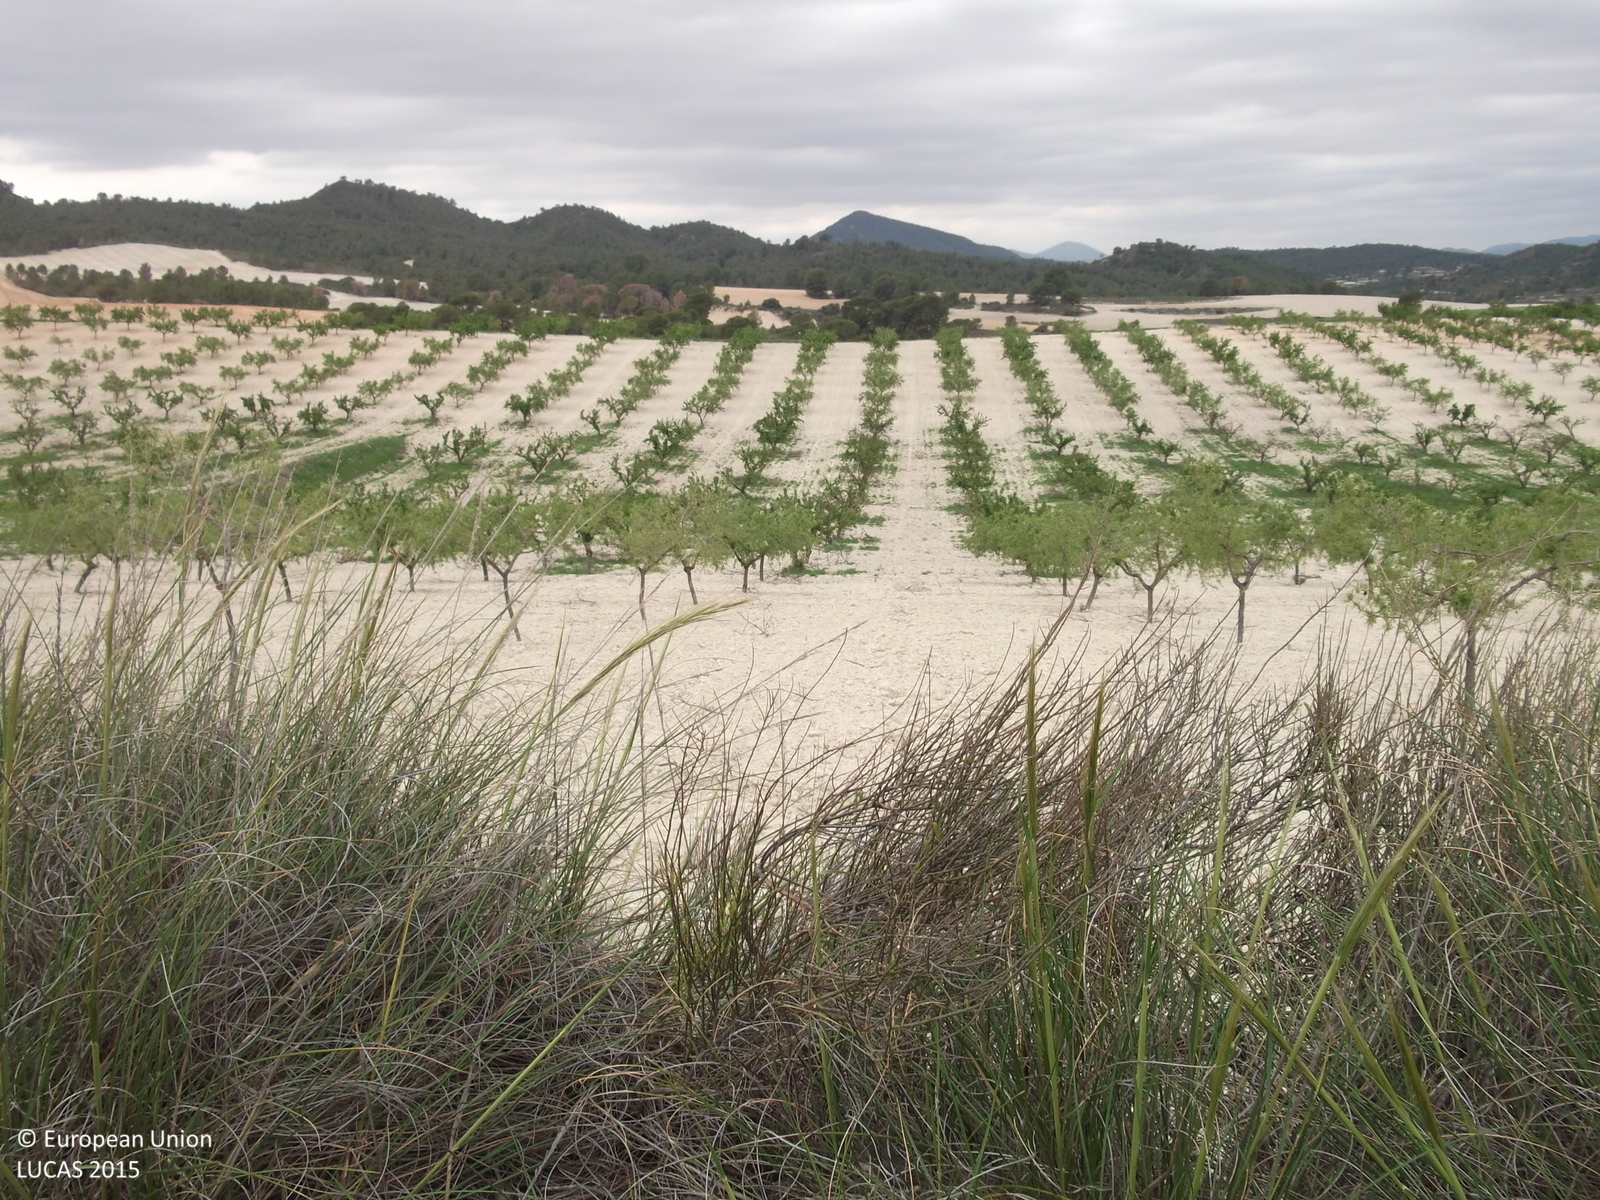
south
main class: Shrubland
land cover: Shrubland without tree cover
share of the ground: 50 - 75 %
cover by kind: shrubs 50 %, herbaceous plants 50 %
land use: Abandoned areas
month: April
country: ES
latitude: 38.1341
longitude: -1.5908
